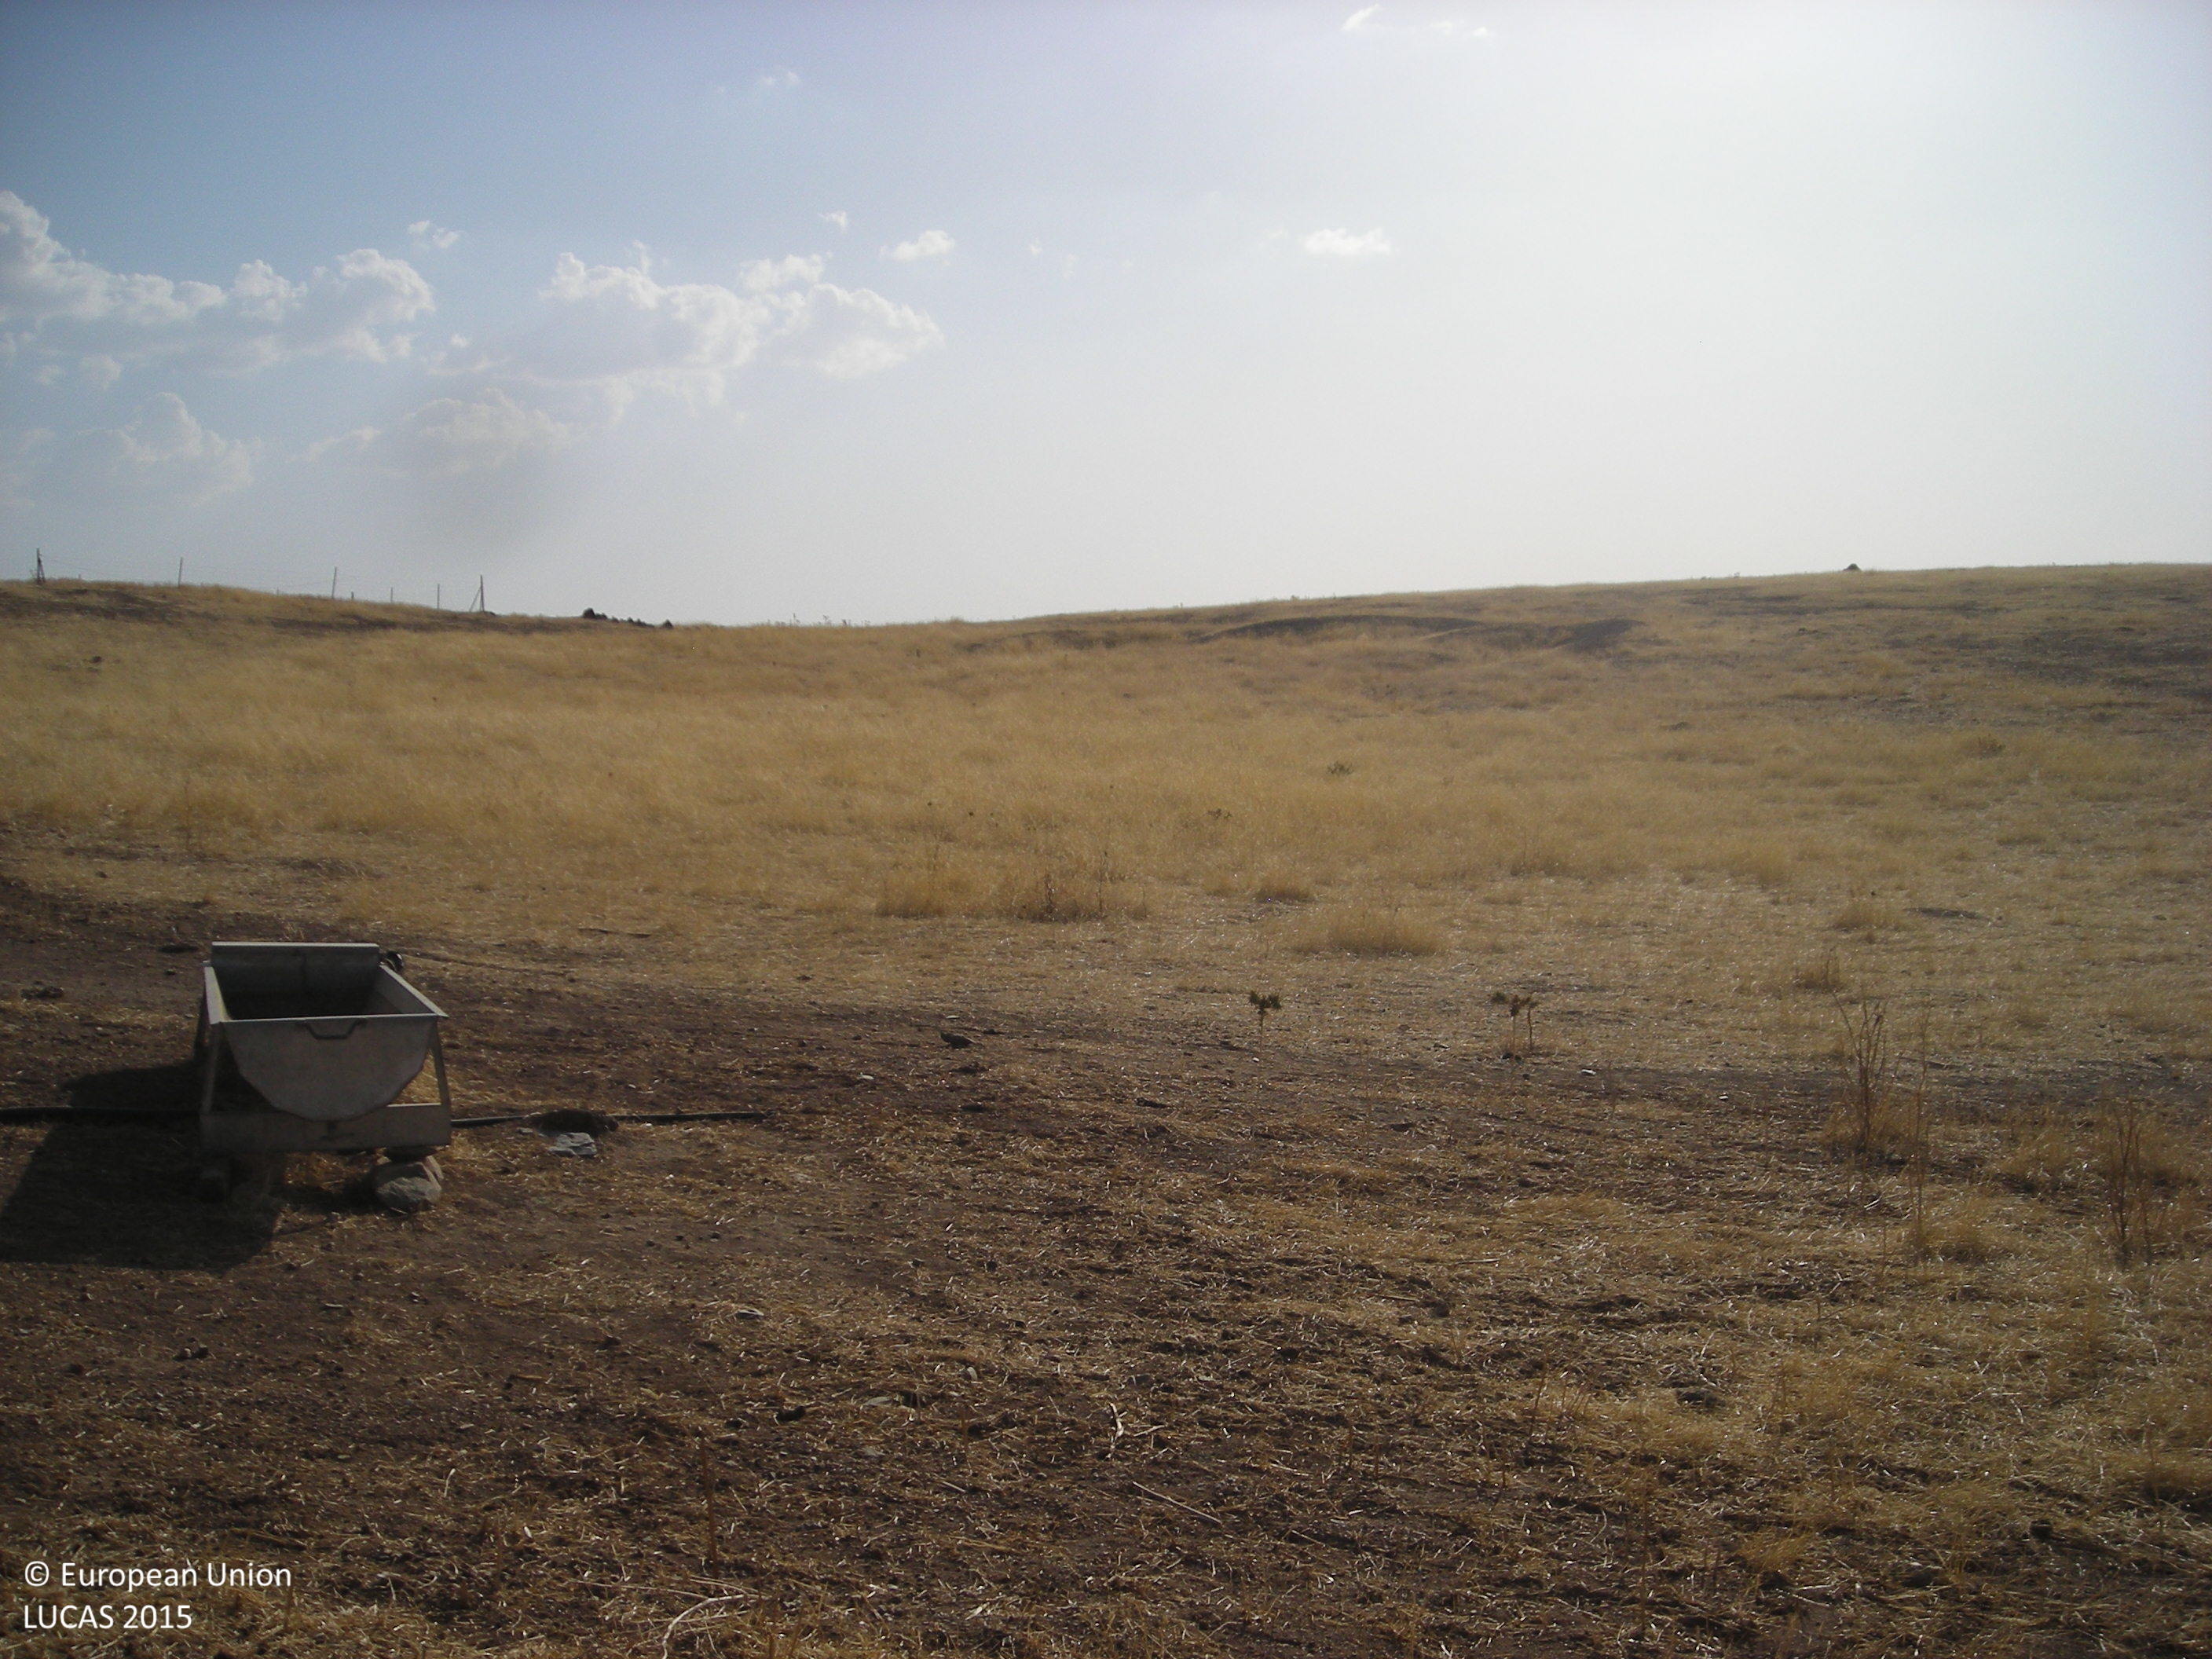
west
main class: Grassland
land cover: Grassland without tree/shrub cover
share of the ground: > 75 %
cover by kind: herbaceous plants 100 %
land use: Agriculture (excluding fallow land and kitchen gardens)
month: July
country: ES
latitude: 38.8837
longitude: -5.4772
